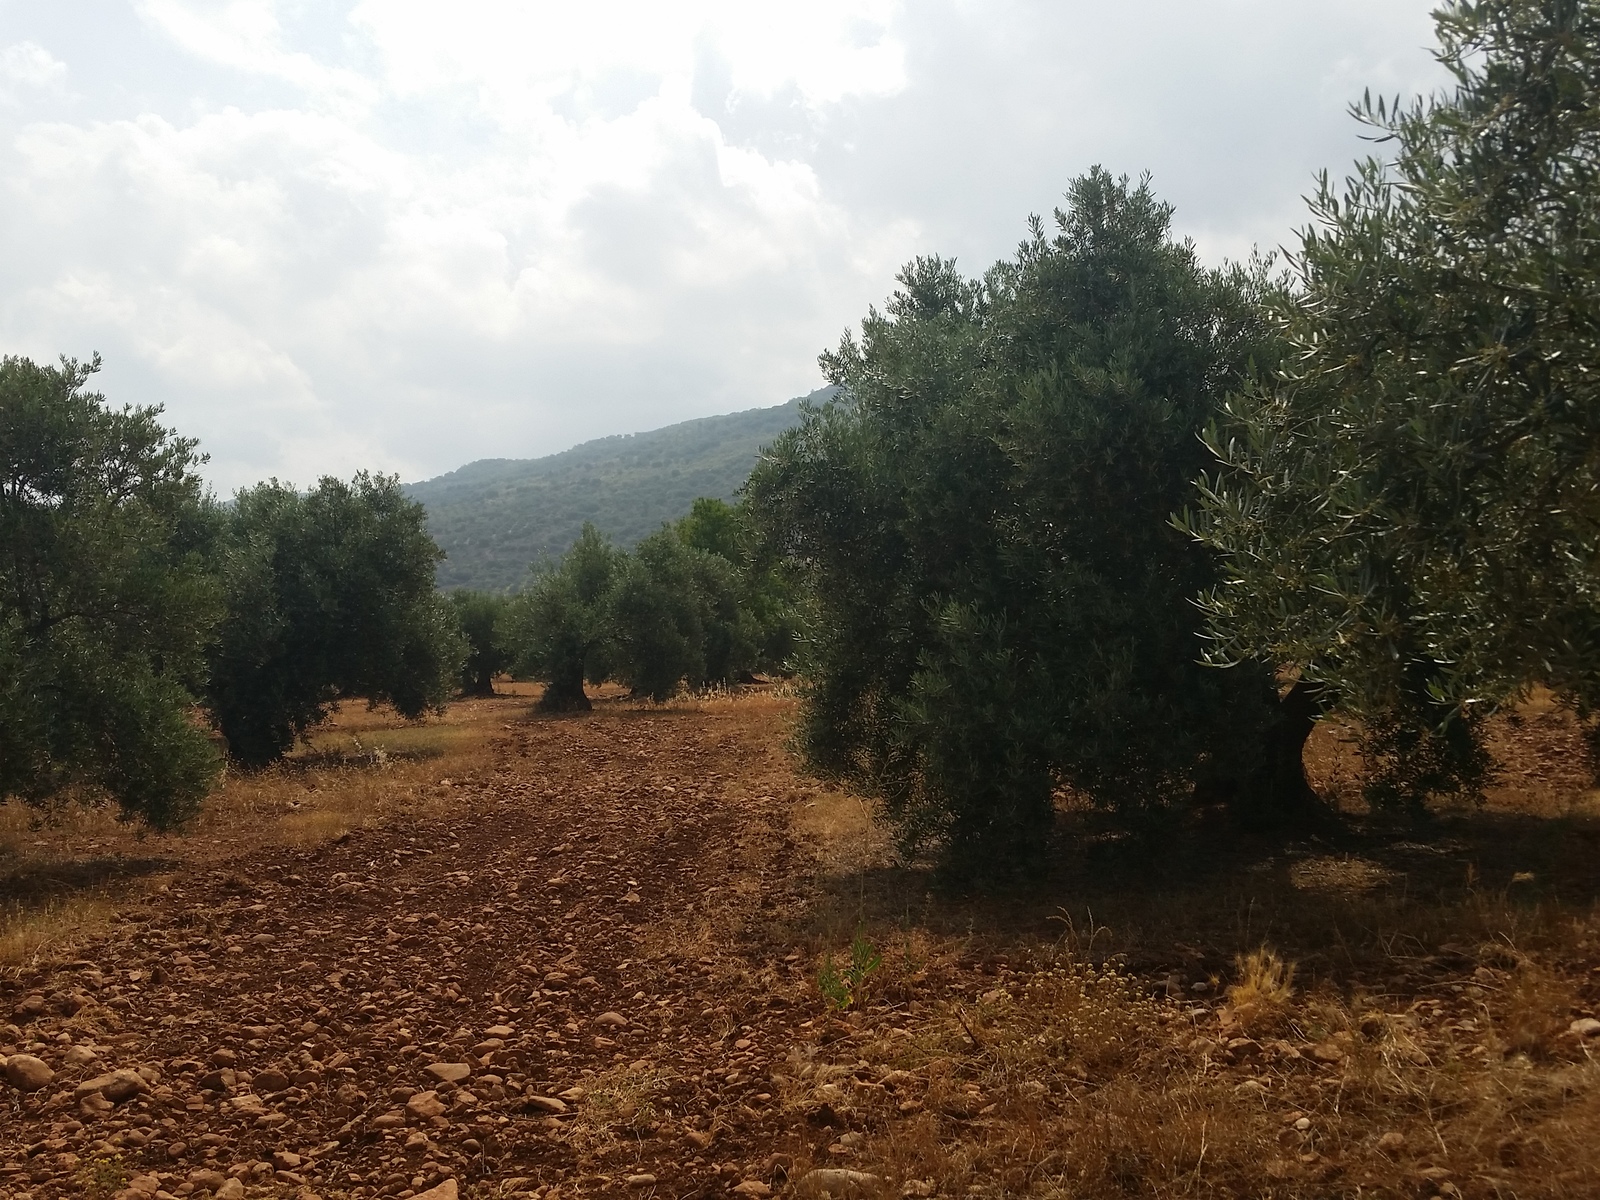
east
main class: Cropland
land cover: Olive groves
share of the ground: 50 - 75 %
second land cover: Grassland without tree/shrub cover
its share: 25 - 50 %
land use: Agriculture (excluding fallow land and kitchen gardens)
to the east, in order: Olive groves; Grassland without tree/shrub cover; Spontaneously vegetated surfaces
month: June
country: ES
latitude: 38.5711
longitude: -2.6149
